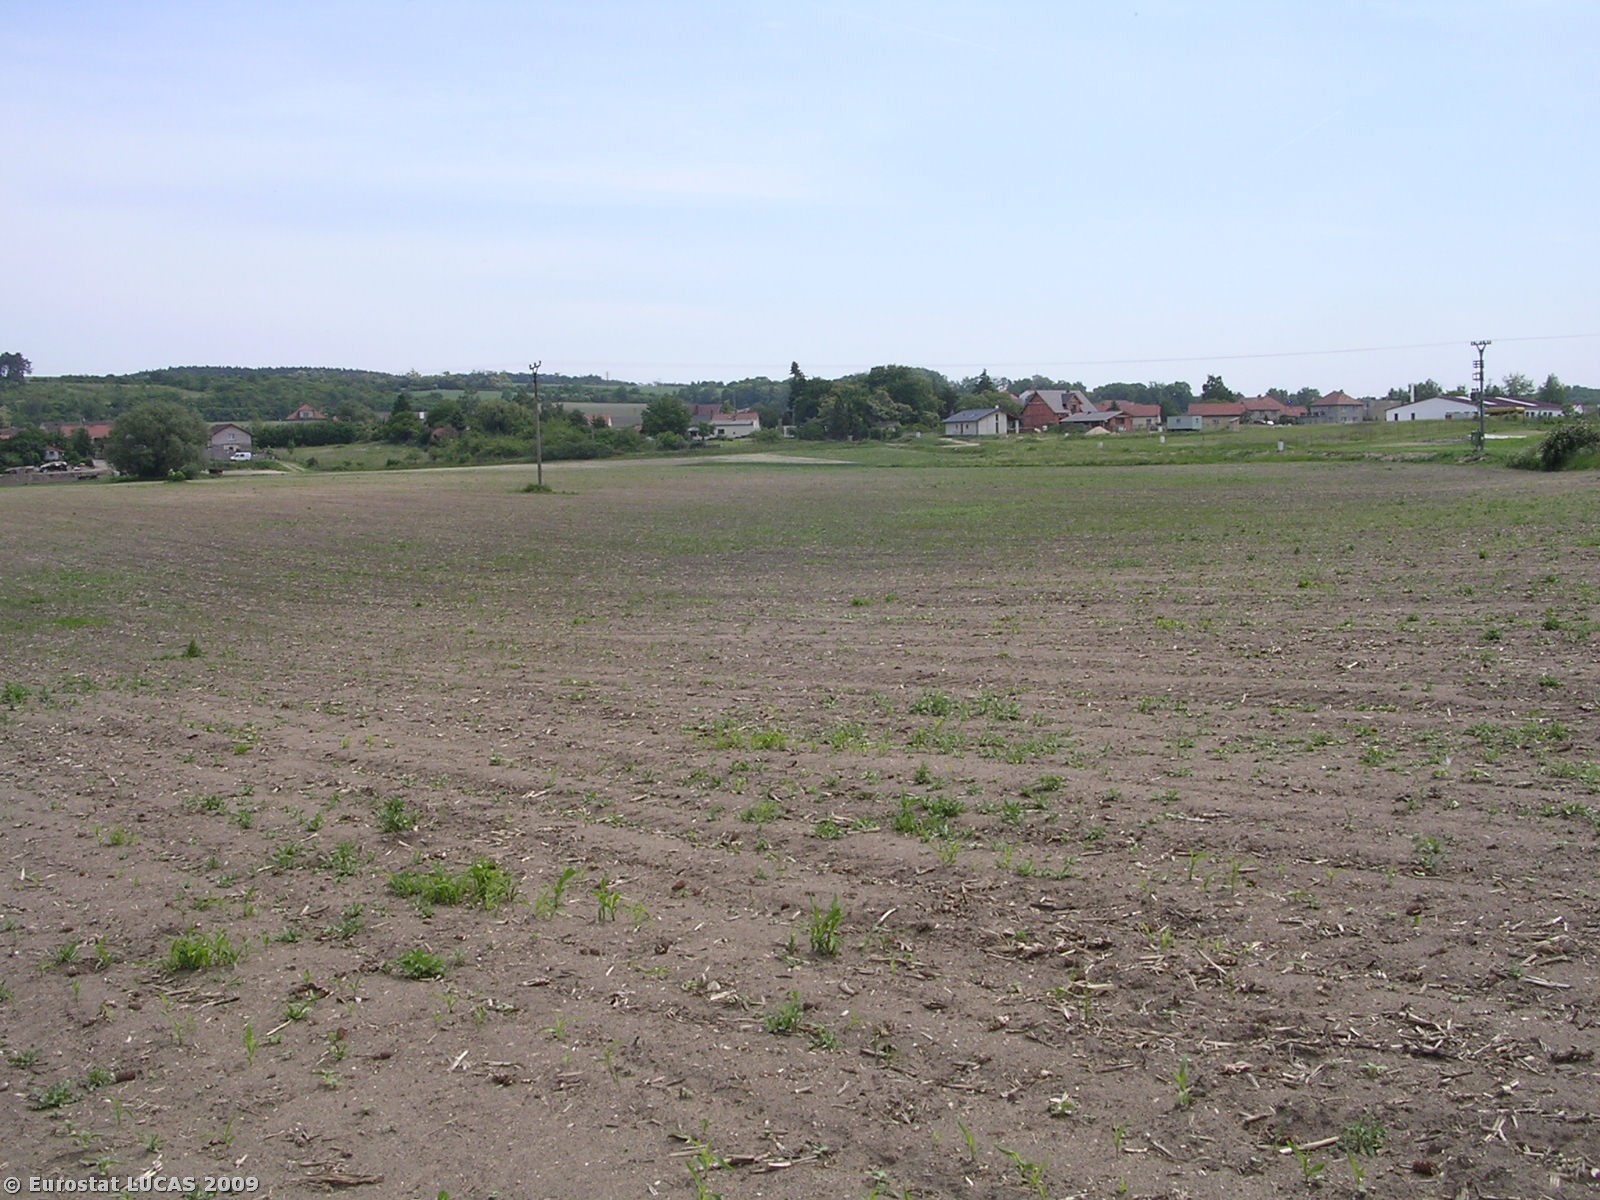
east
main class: Cropland
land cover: Sunflower
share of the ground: < 10 %
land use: Agriculture (excluding fallow land and kitchen gardens)
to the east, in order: Sunflower; Electric lines; Sunflower; Electric lines; Sunflower
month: May
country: CZ
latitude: 50.3112
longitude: 14.5093
